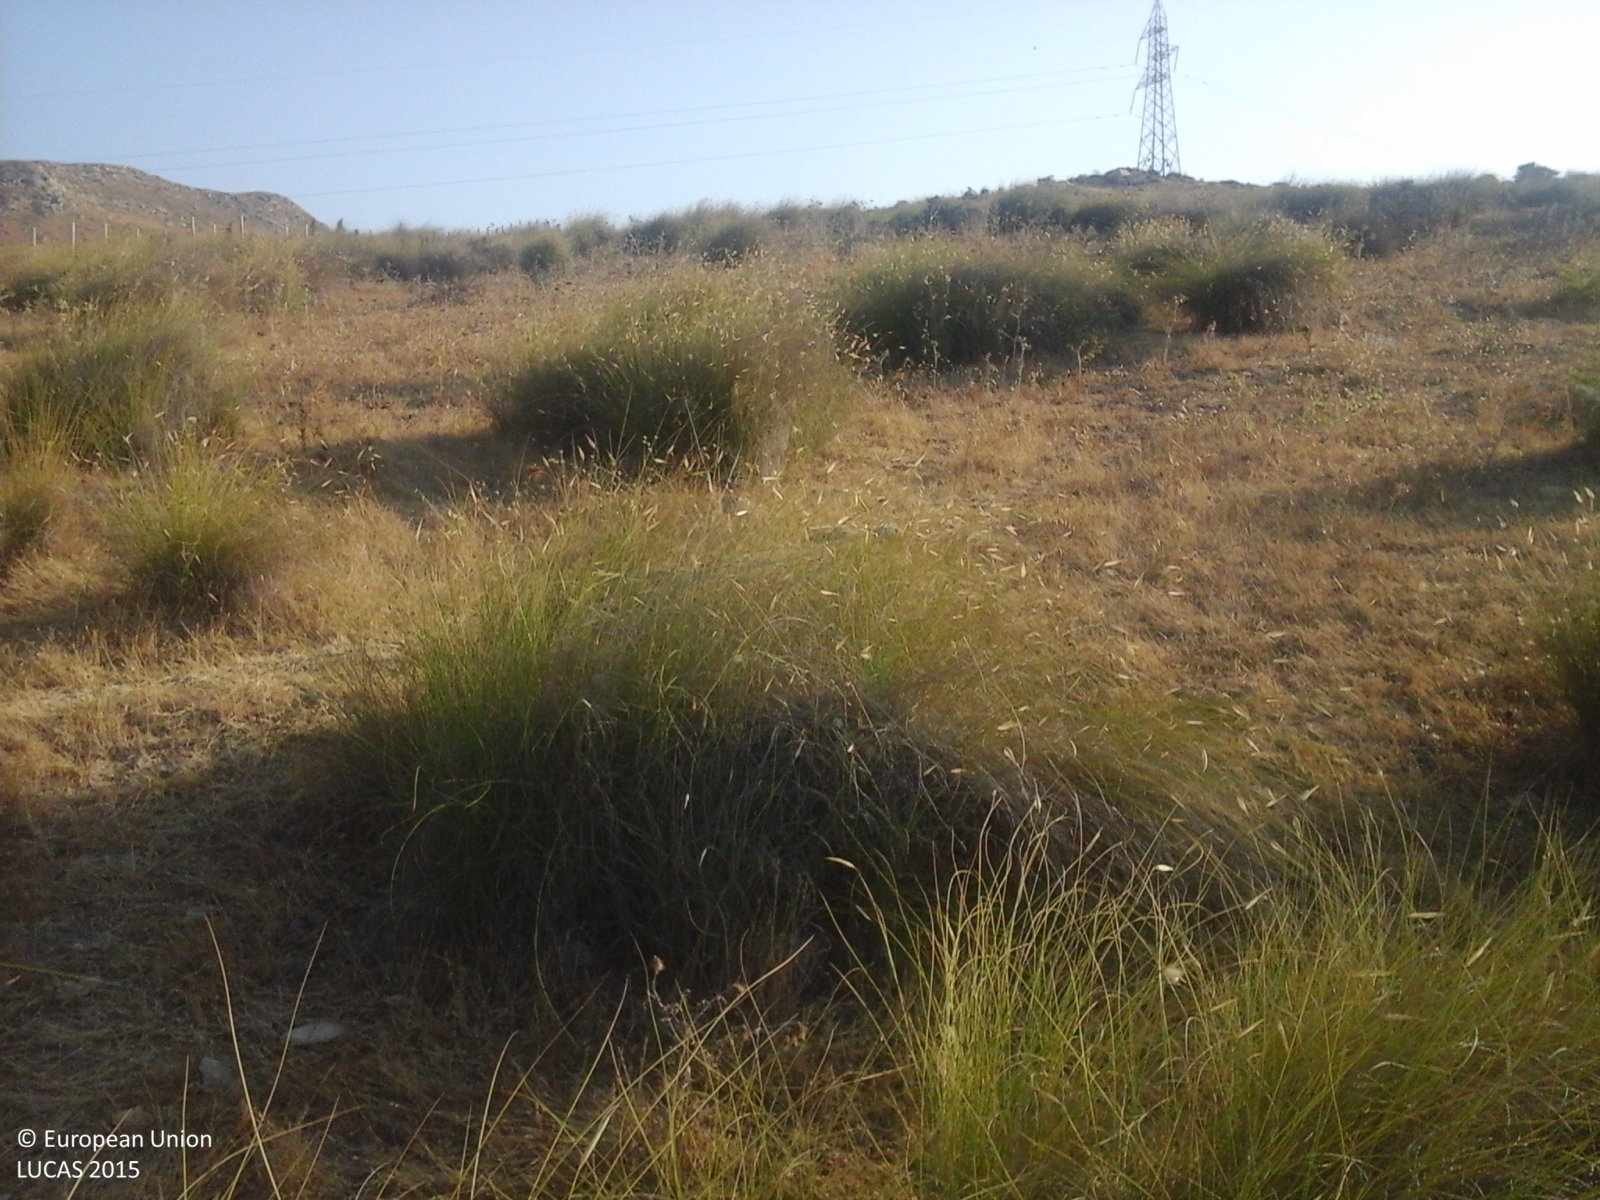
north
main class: Grassland
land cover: Grassland without tree/shrub cover
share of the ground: > 75 %
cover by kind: herbaceous plants 100 %
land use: Semi-natural and natural areas not in use
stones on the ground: < 10 %
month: July
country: IT
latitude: 37.1176
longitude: 14.0086
